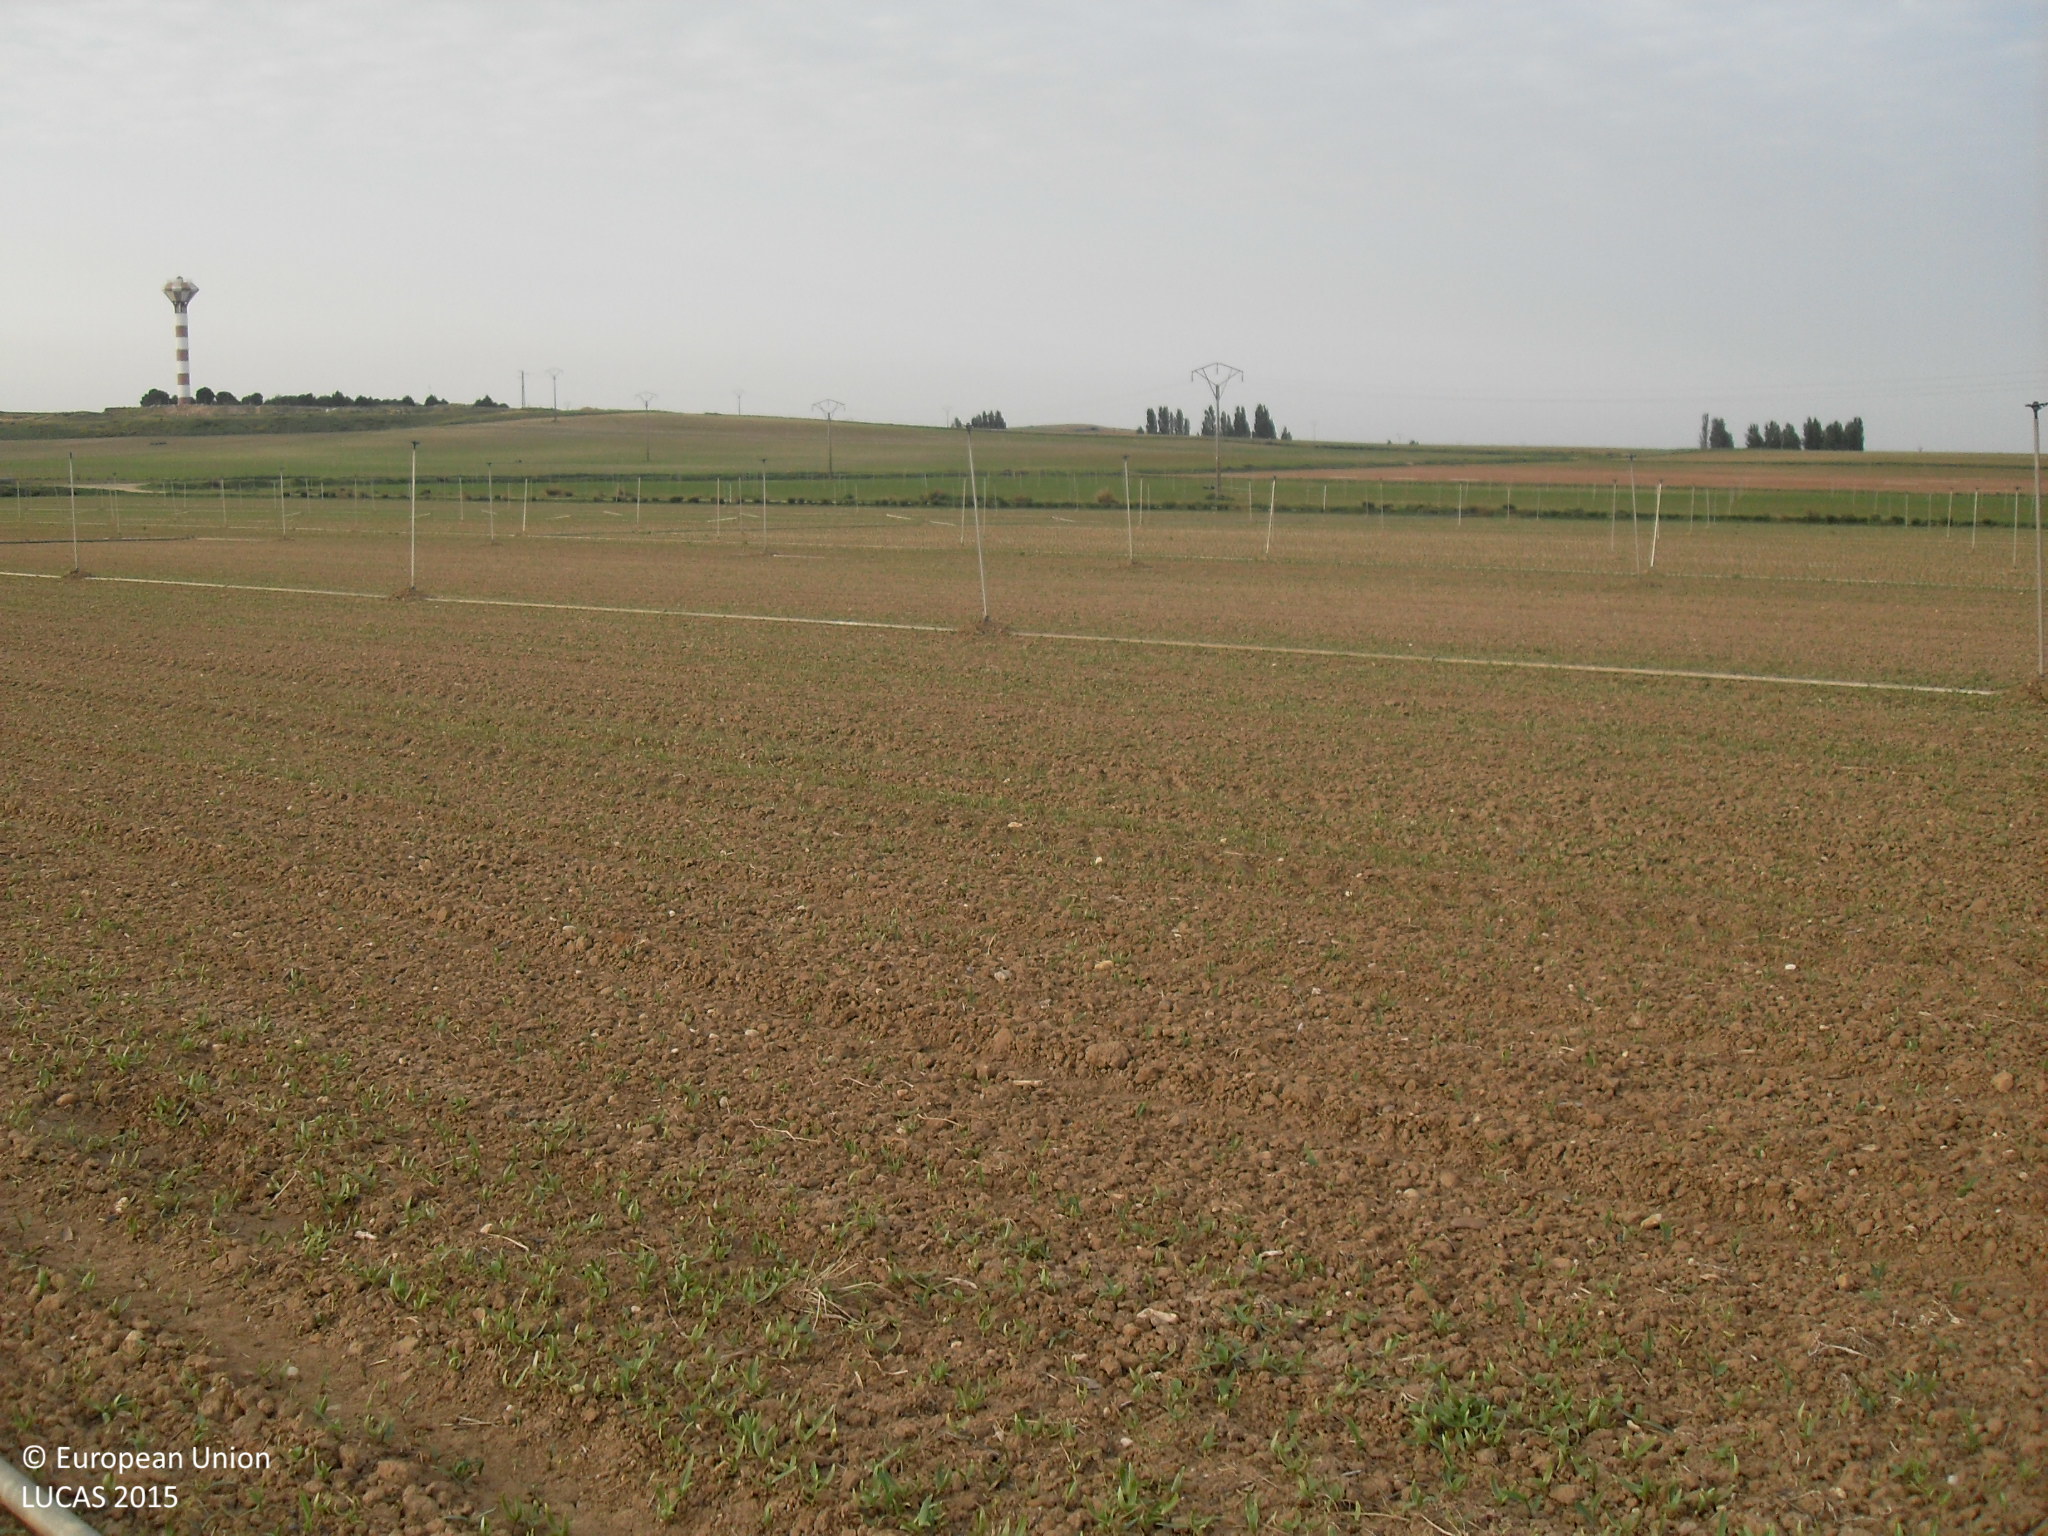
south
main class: Cropland
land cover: Maize
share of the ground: > 75 %
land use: Agriculture (excluding fallow land and kitchen gardens)
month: May
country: ES
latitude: 40.9739
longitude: -5.3903
